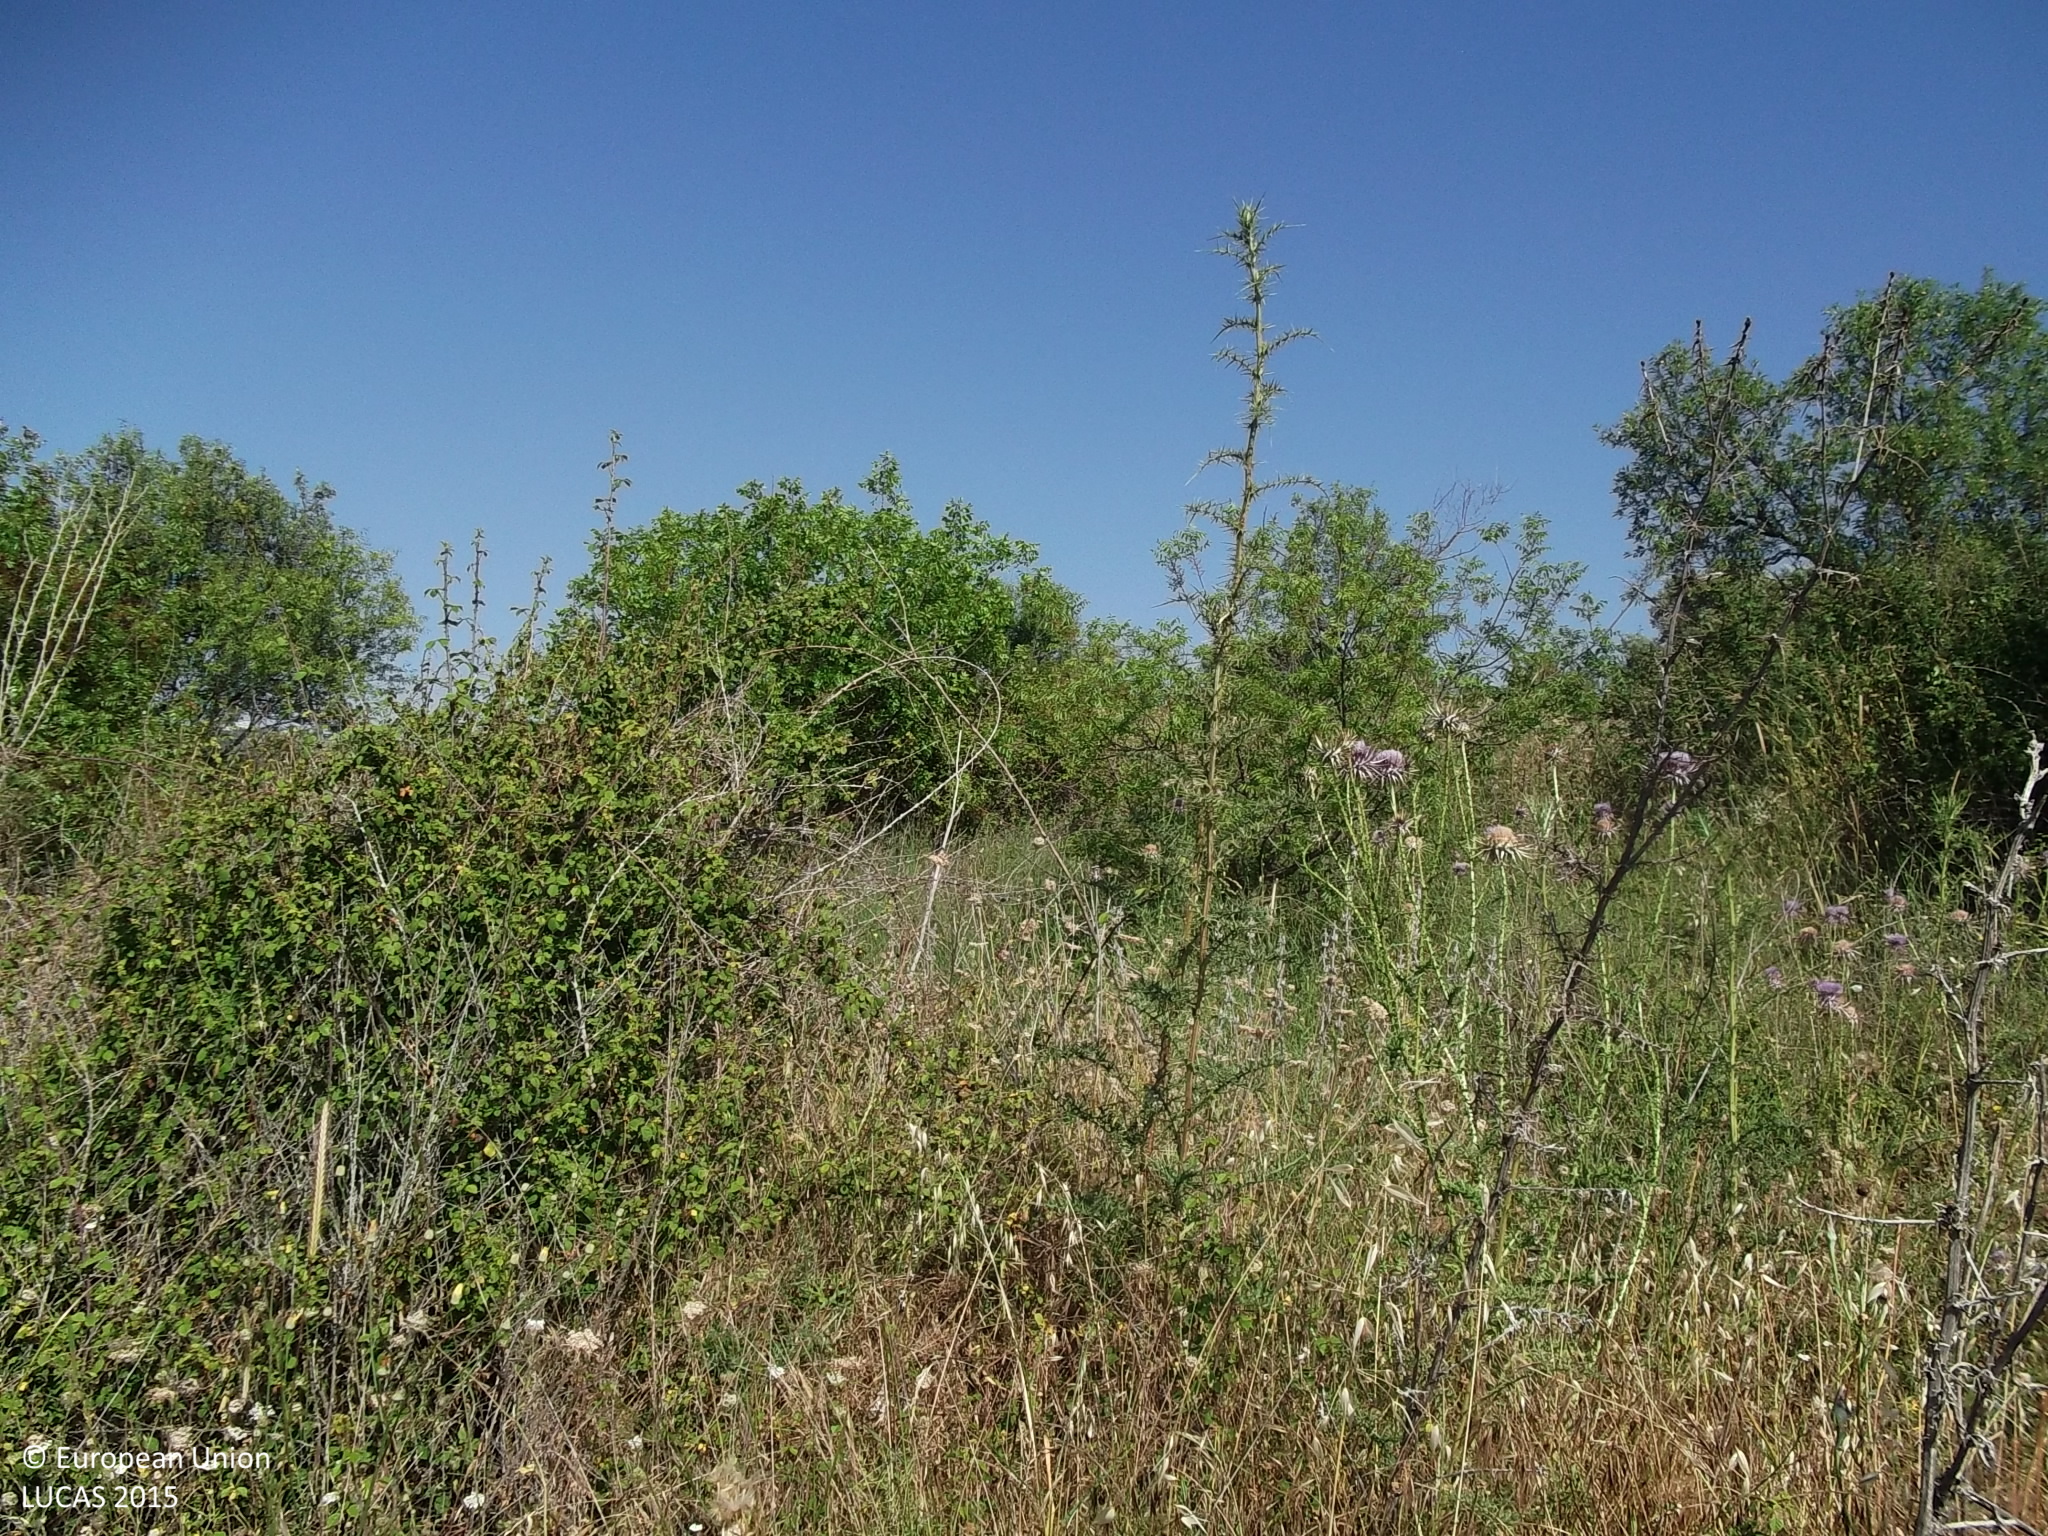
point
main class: Grassland
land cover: Grassland with sparse tree/shrub cover
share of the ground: > 75 %
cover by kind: herbaceous plants 90 %, broadleaved forest trees 5 %, shrubs 5 %
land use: Semi-natural and natural areas not in use
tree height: < 5 m
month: May
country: CY
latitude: 34.8835
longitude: 32.5724
